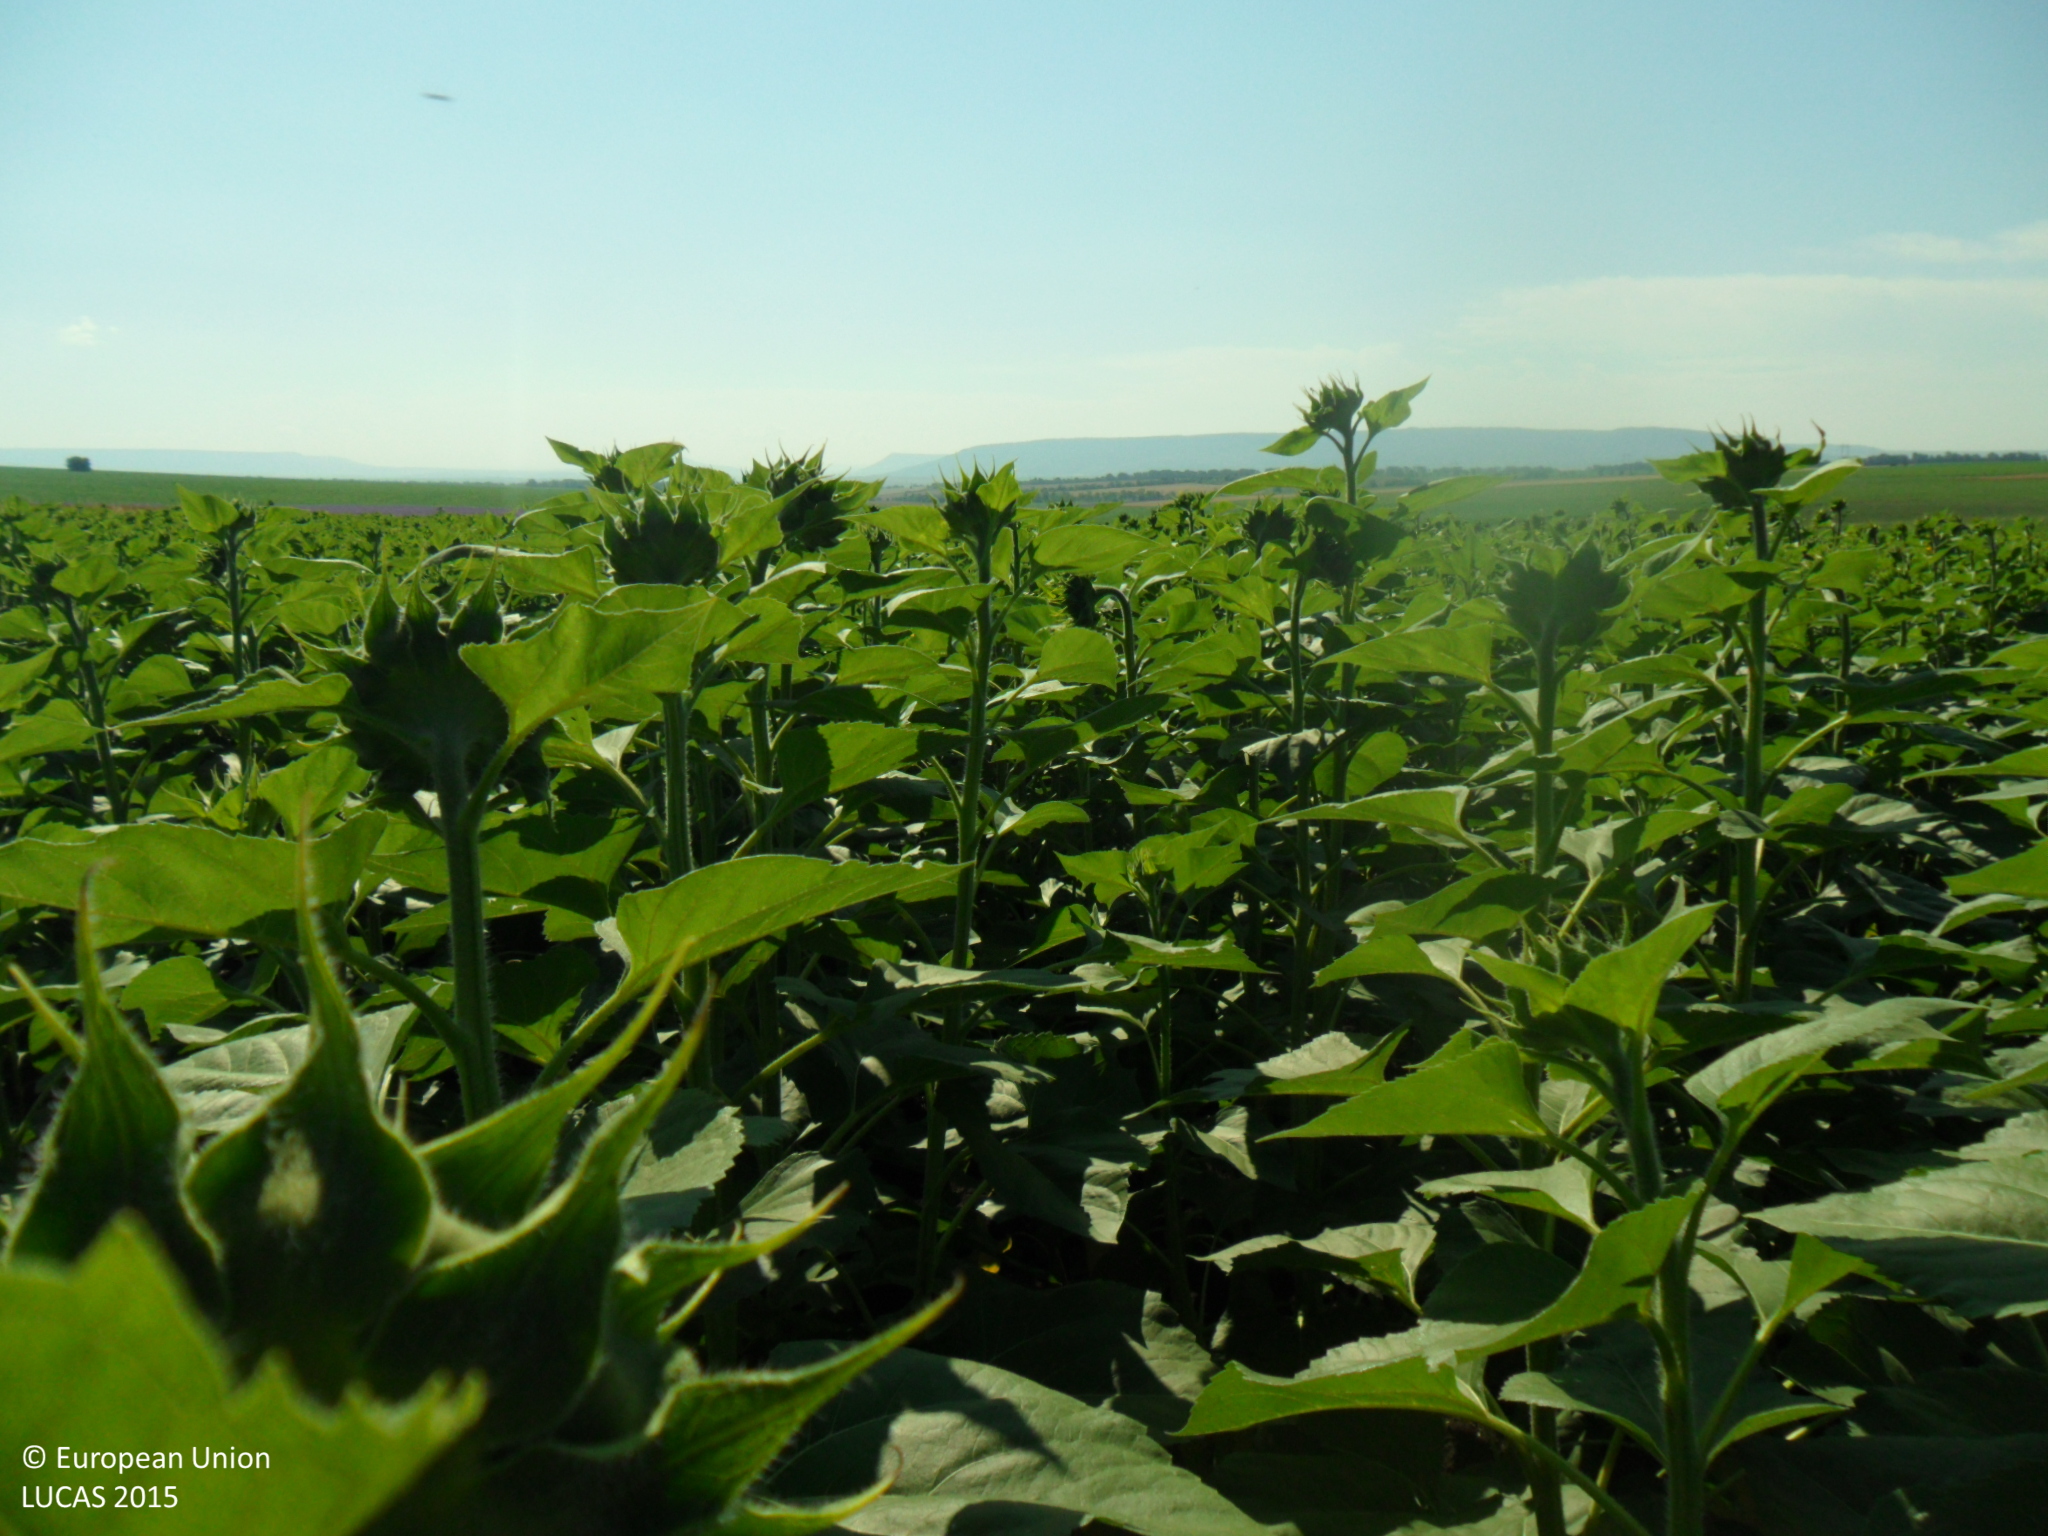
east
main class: Cropland
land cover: Sunflower
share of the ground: > 75 %
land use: Agriculture (excluding fallow land and kitchen gardens)
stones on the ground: < 10 %
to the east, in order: Sunflower; Grass margins; Common wheat; Grass margins; Tracks; Grass margins; Permanent industrial crops
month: June
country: BG
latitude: 43.3357
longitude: 27.0261
